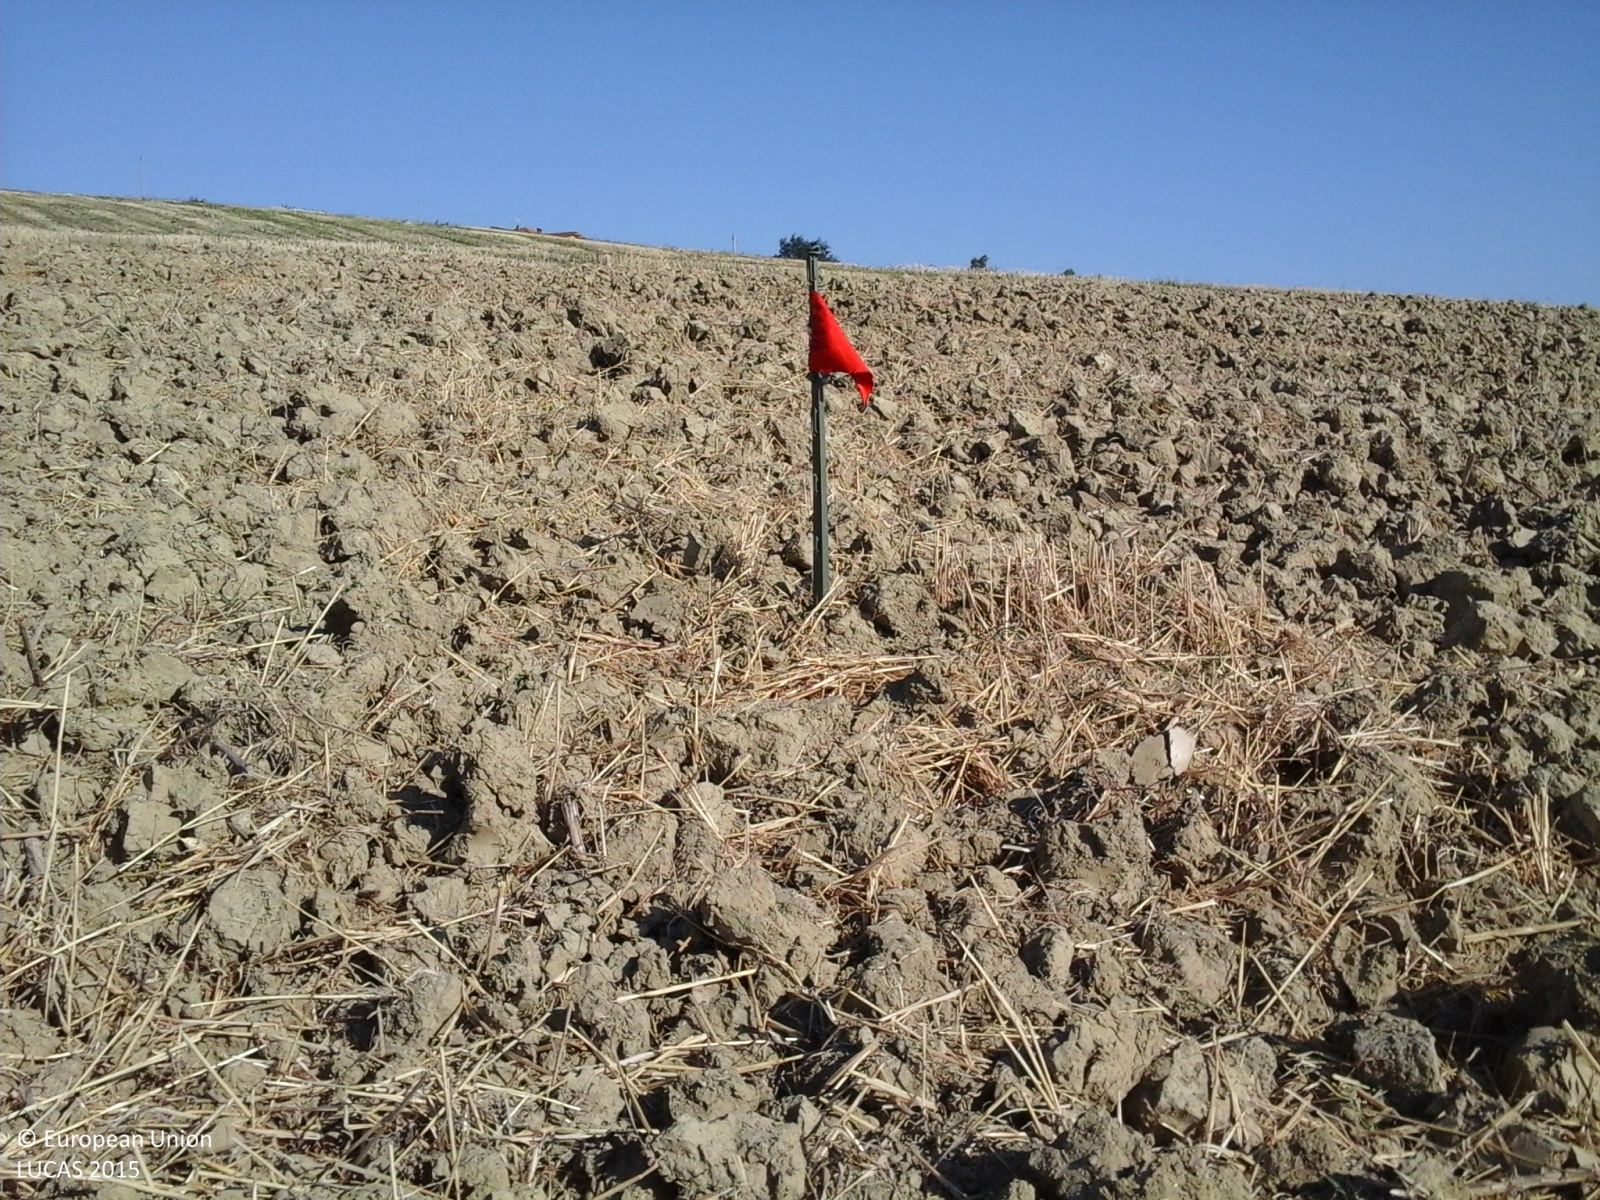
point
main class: Cropland
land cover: Common wheat
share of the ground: < 10 %
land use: Agriculture (excluding fallow land and kitchen gardens)
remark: Harvested field
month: July
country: IT
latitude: 43.9185
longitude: 12.6962
